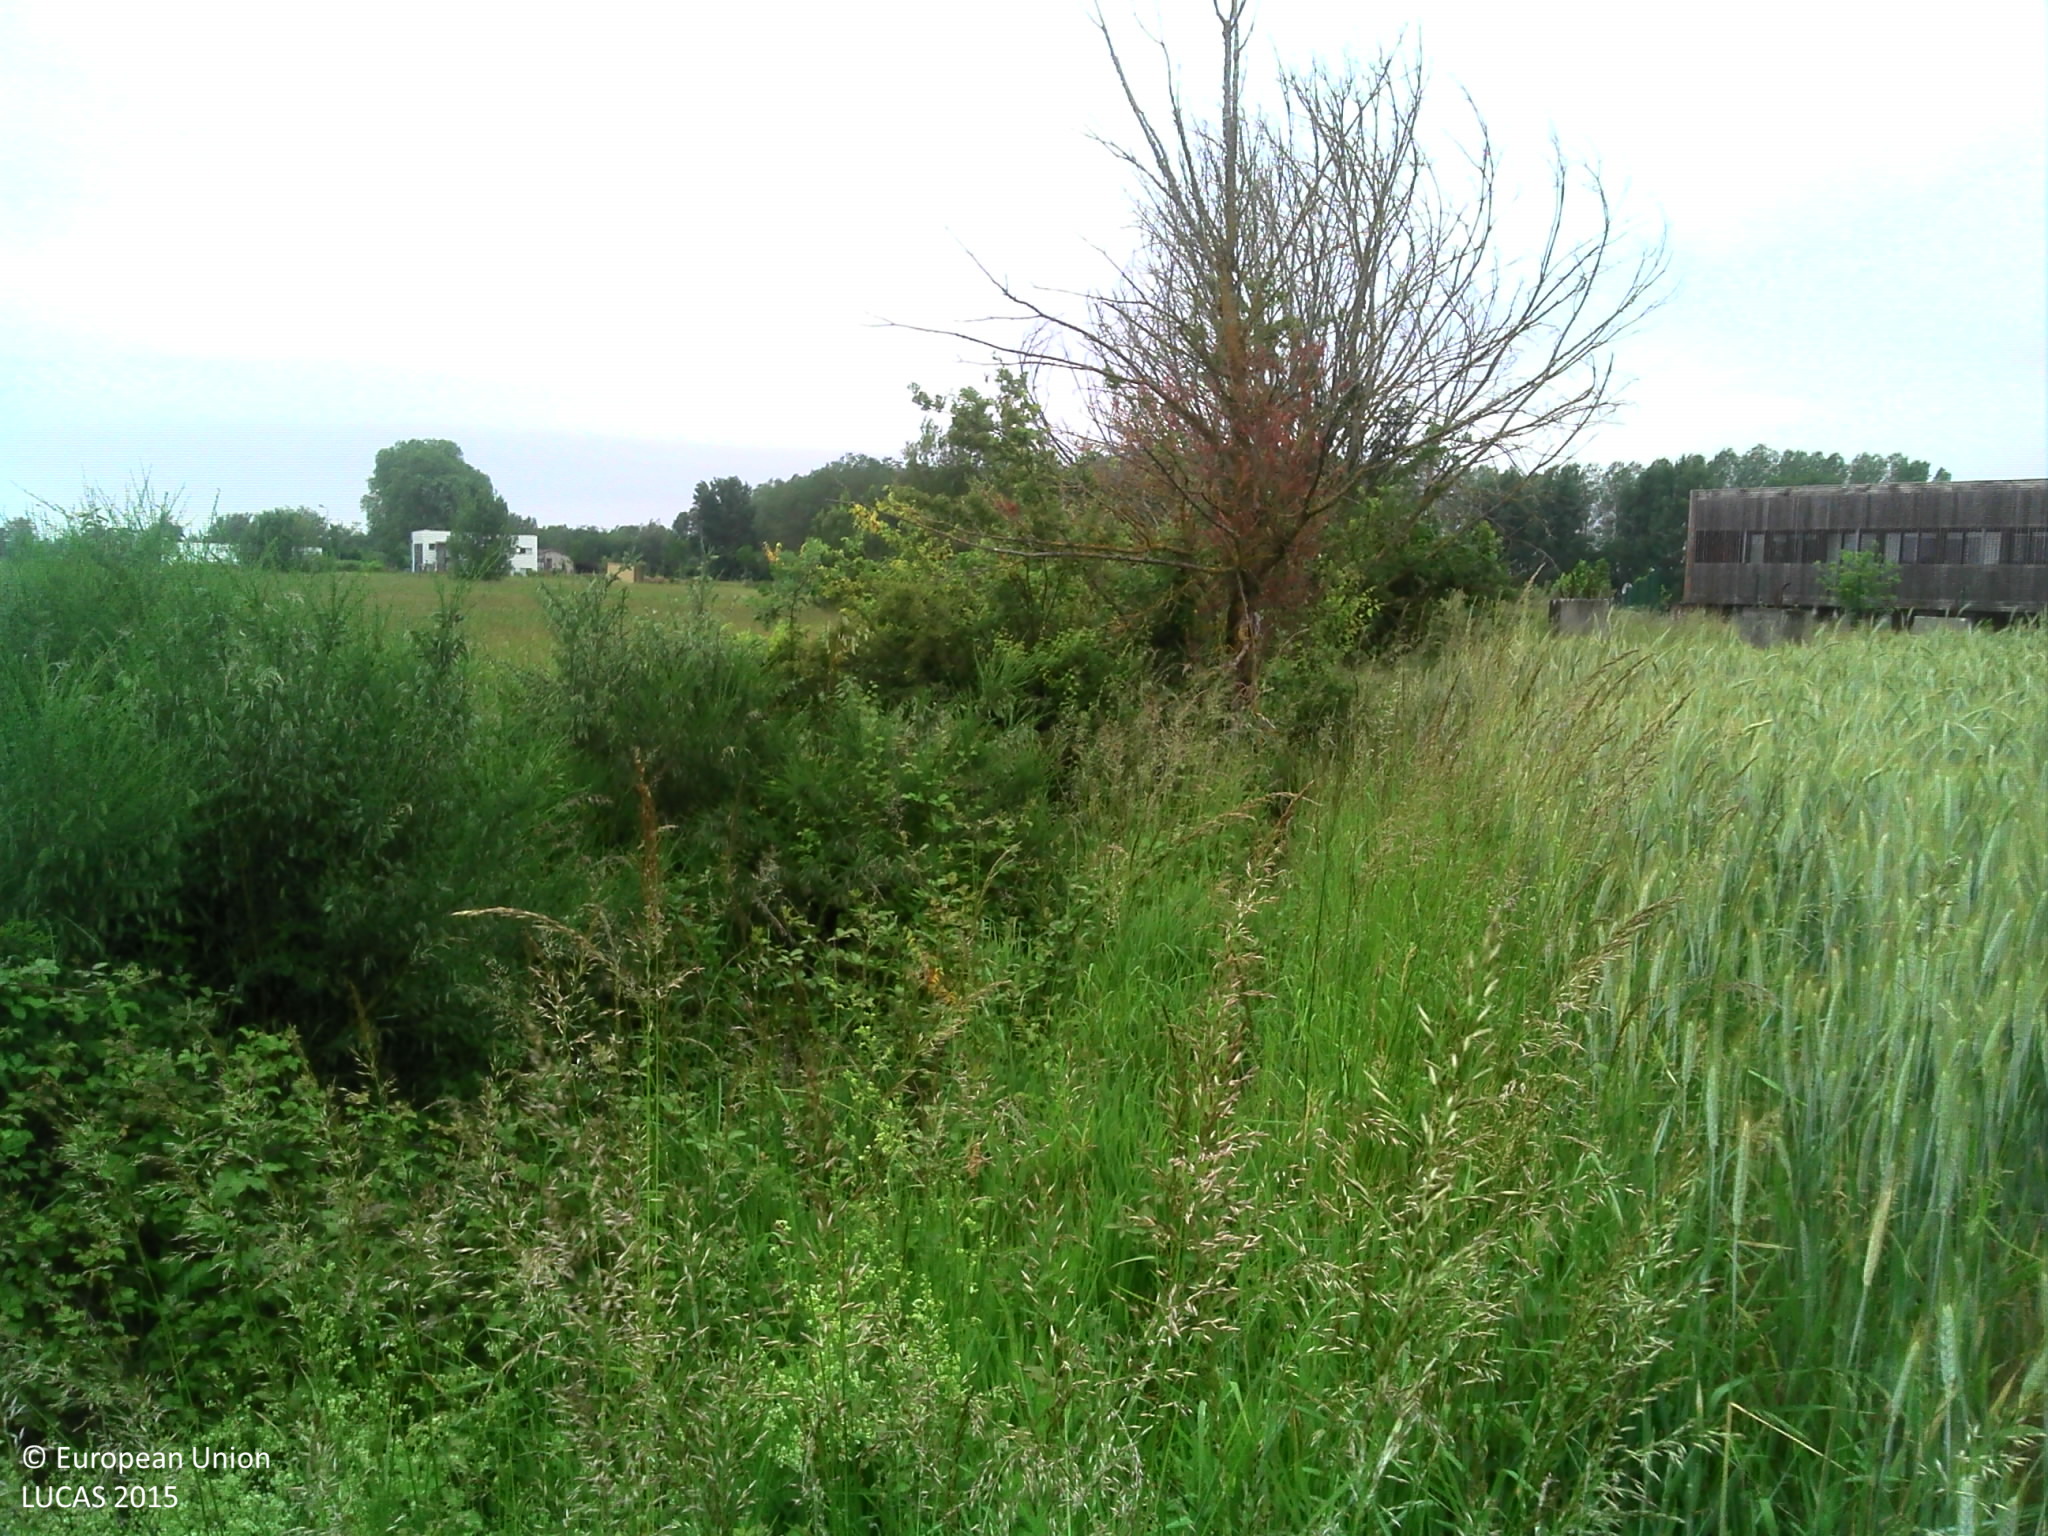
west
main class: Shrubland
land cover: Shrubland with sparse tree cover
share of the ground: > 75 %
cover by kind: shrubs 95 %, broadleaved forest trees 5 %
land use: Fallow land
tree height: < 5 m
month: May
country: FR
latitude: 43.7653
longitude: 1.7175
